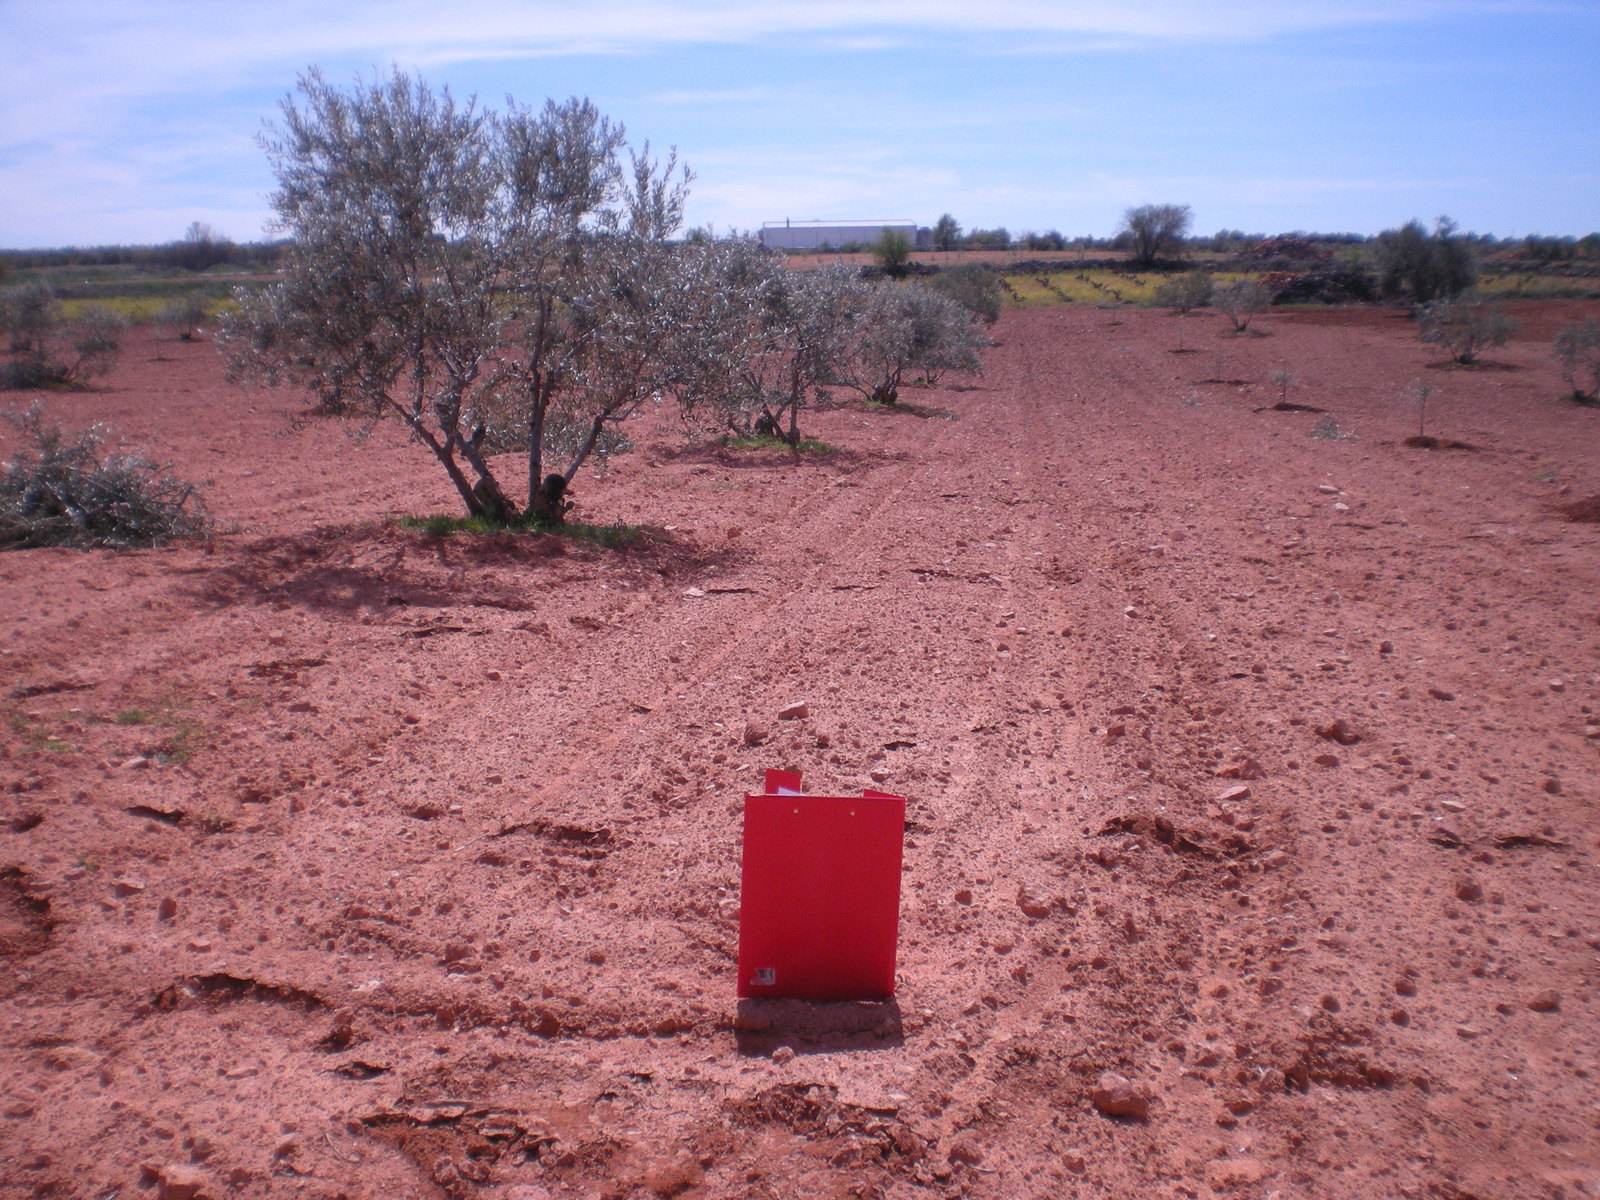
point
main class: Cropland
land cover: Olive groves
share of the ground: 10 - 25 %
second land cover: Other bare soil
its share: > 75 %
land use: Agriculture (excluding fallow land and kitchen gardens)
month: March
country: ES
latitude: 38.9677
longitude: -3.2039
